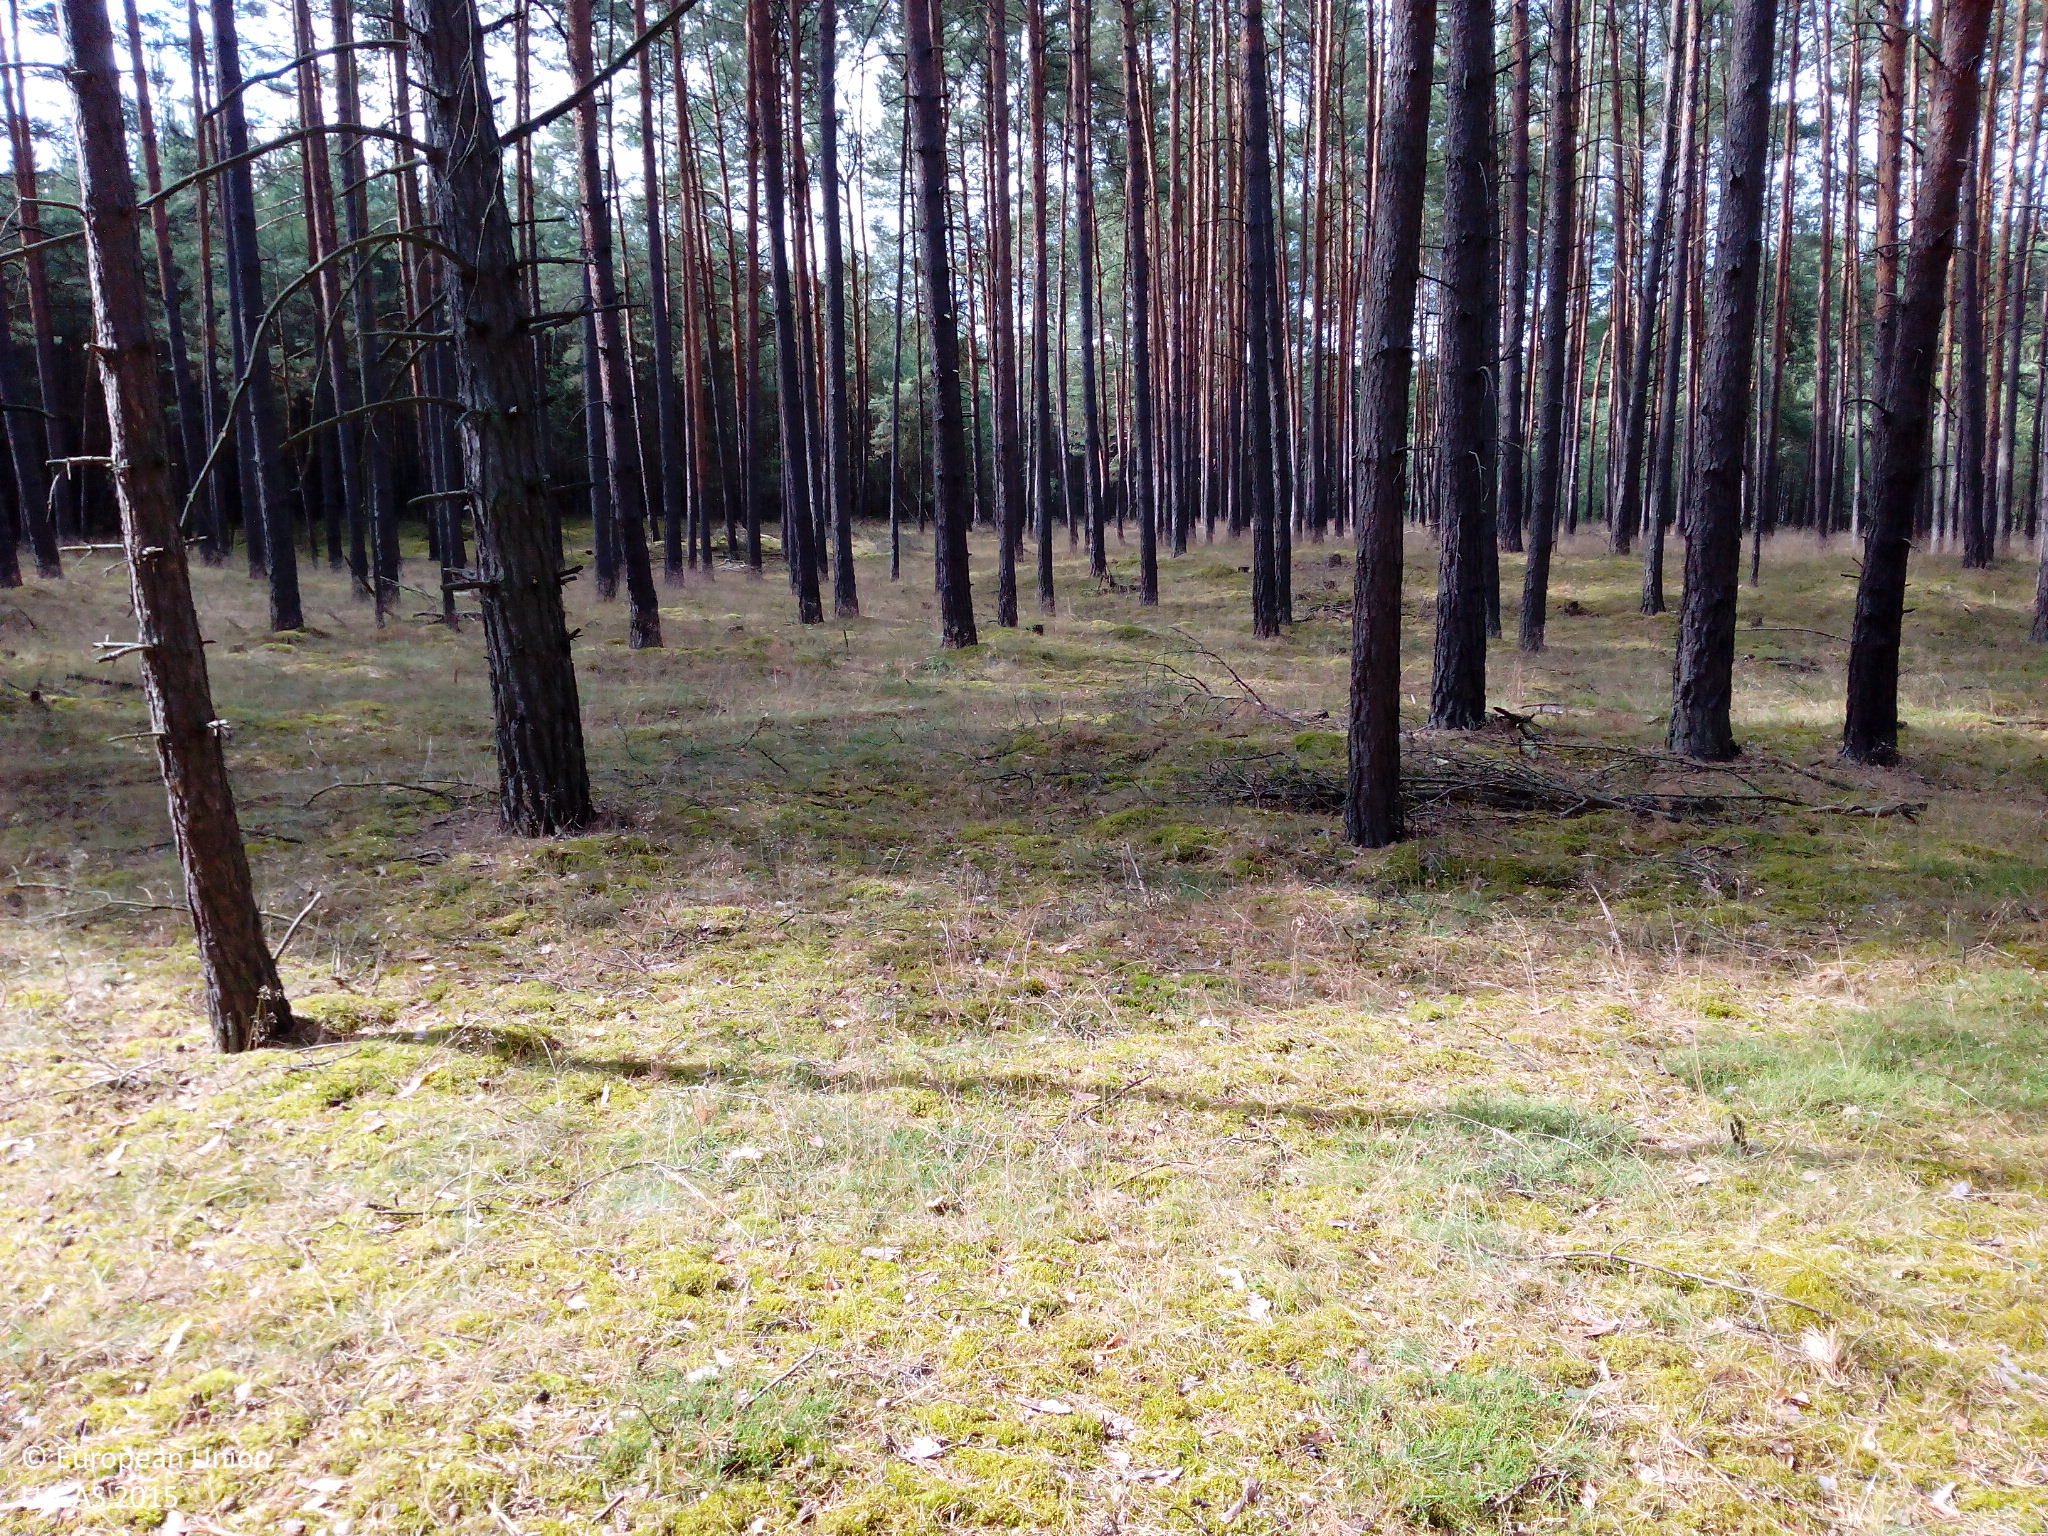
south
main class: Woodland
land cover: Pine dominated coniferous woodland
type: hemiboreal forest and nemoral coniferous forest and mixed broadleaved-coniferous forest
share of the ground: > 75 %
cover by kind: coniferous forest trees 80 %, herbaceous plants 10 %, lichens and mosses 10 %
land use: Forestry
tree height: > 5 m
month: July
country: DE
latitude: 52.8103
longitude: 13.5458
